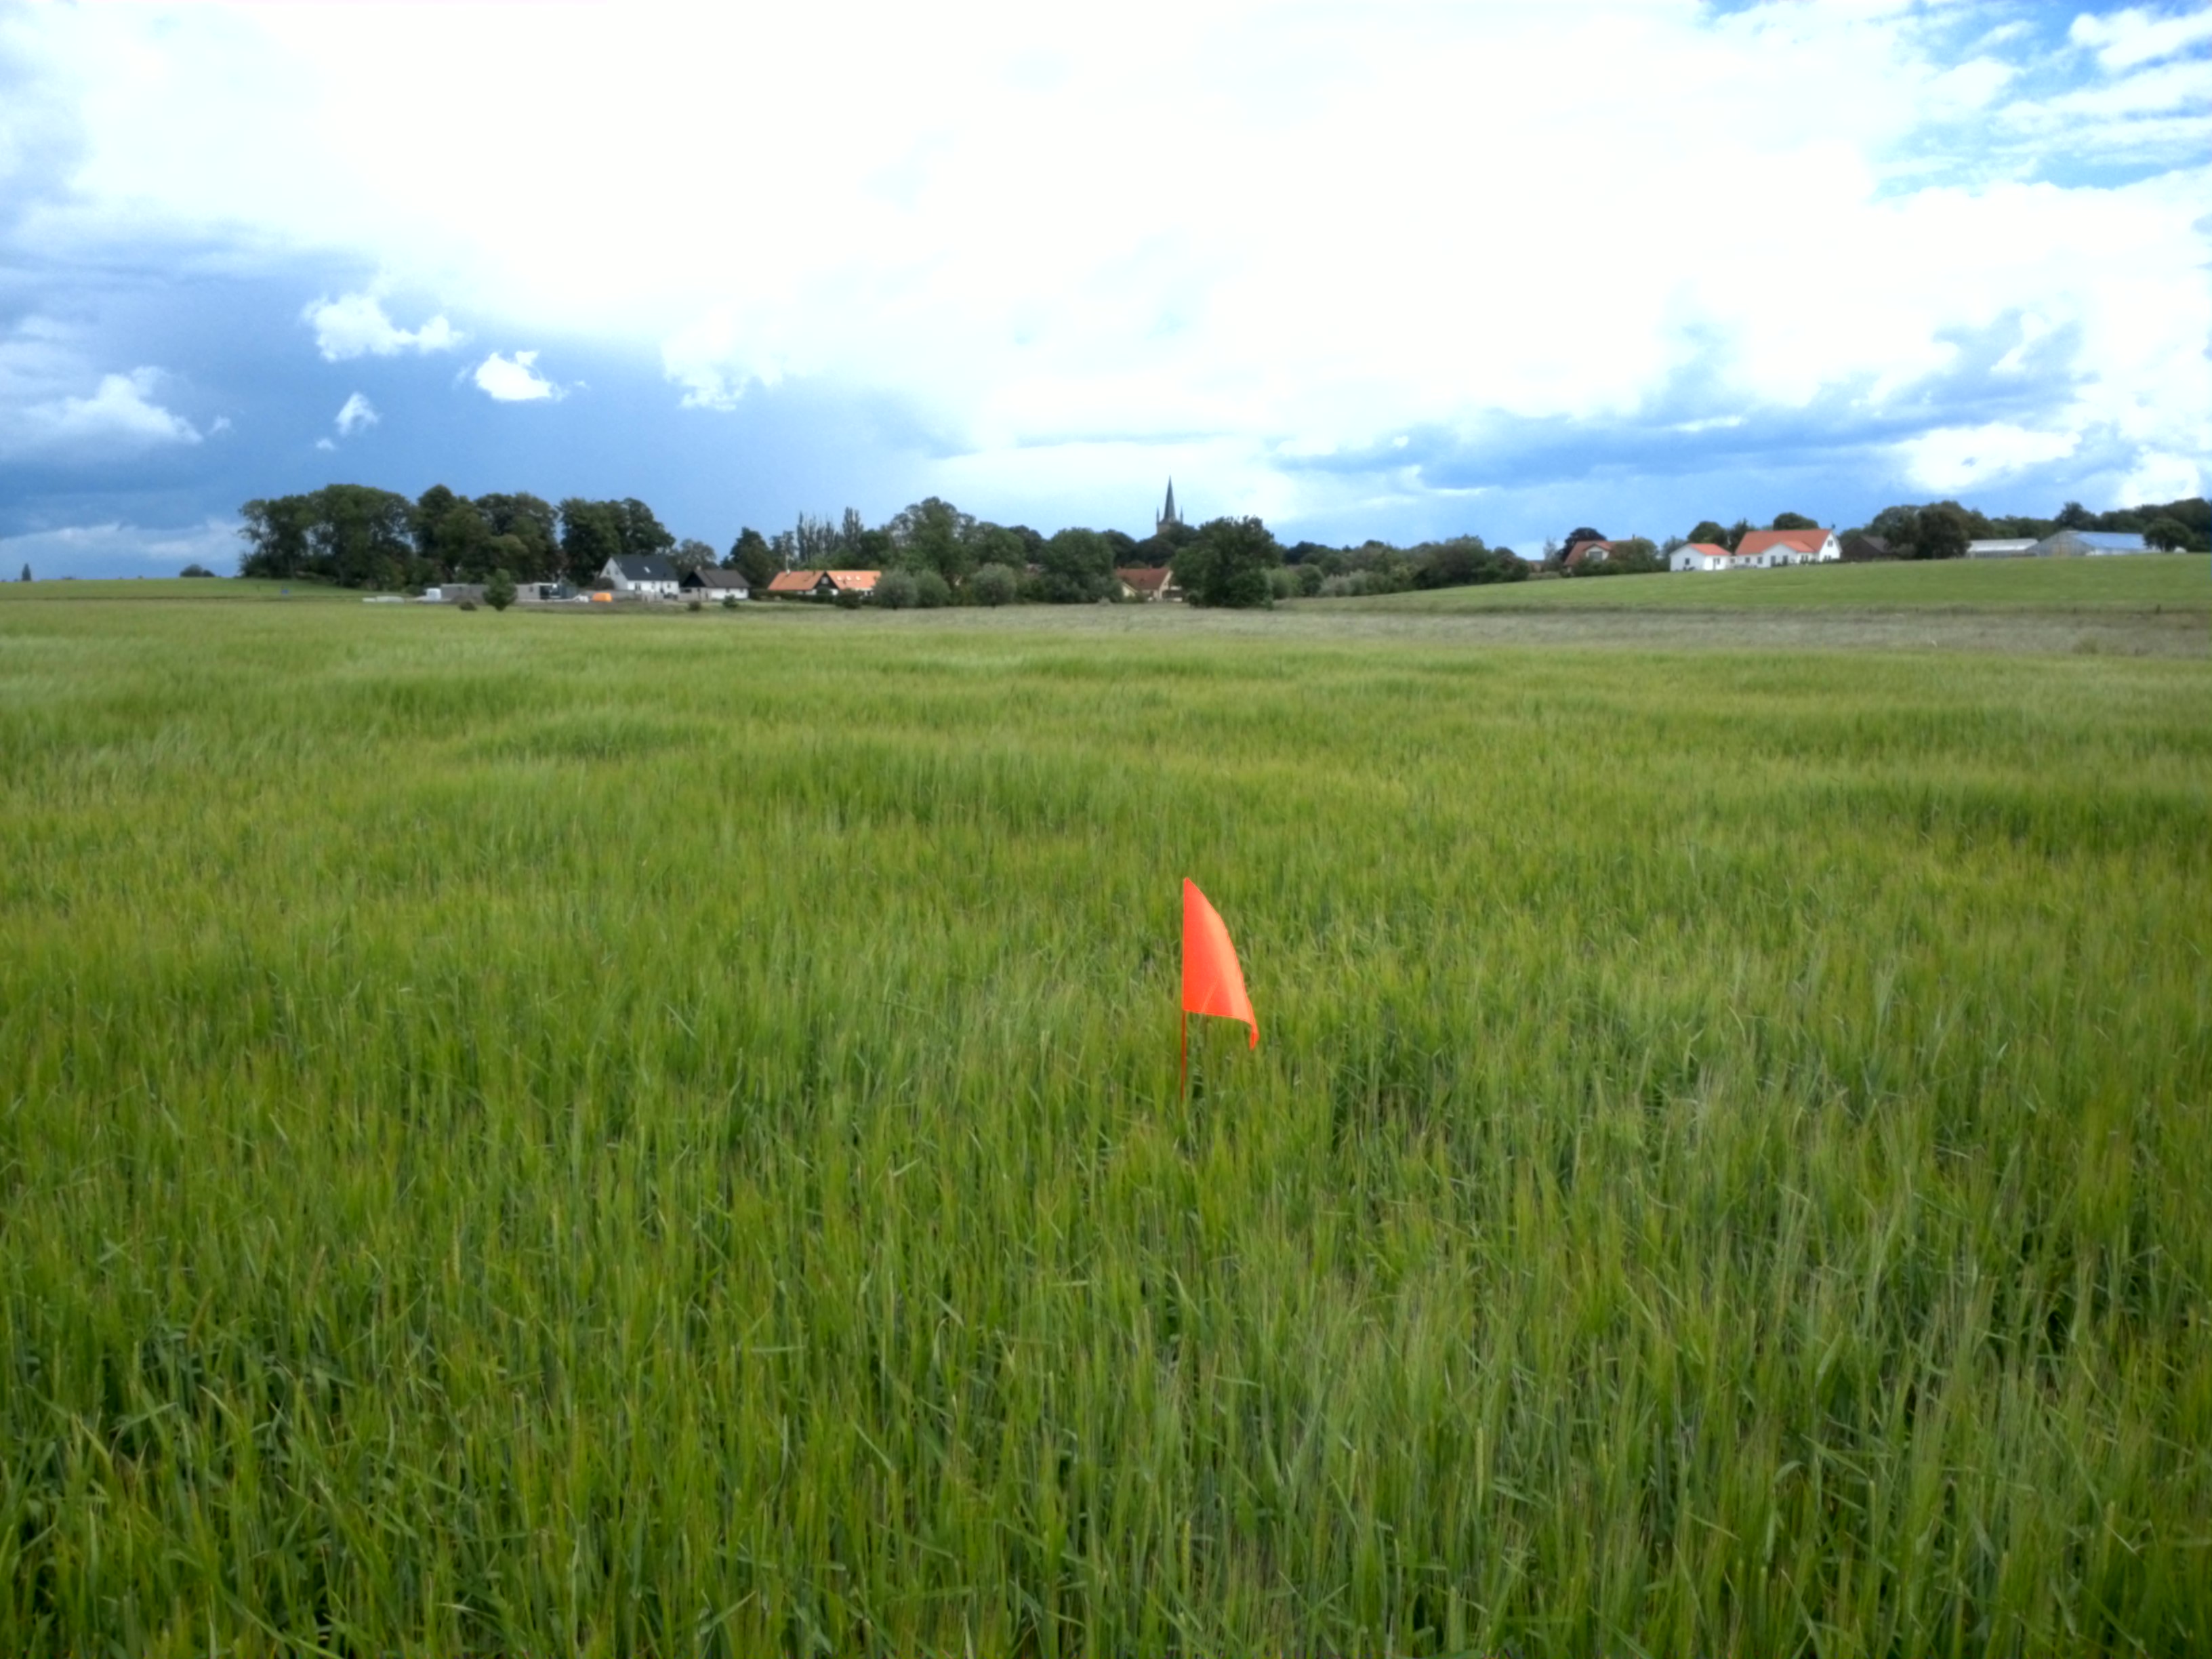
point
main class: Cropland
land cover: Barley
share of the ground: > 75 %
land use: Agriculture (excluding fallow land and kitchen gardens)
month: June
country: SE
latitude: 55.5046
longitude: 13.0221
